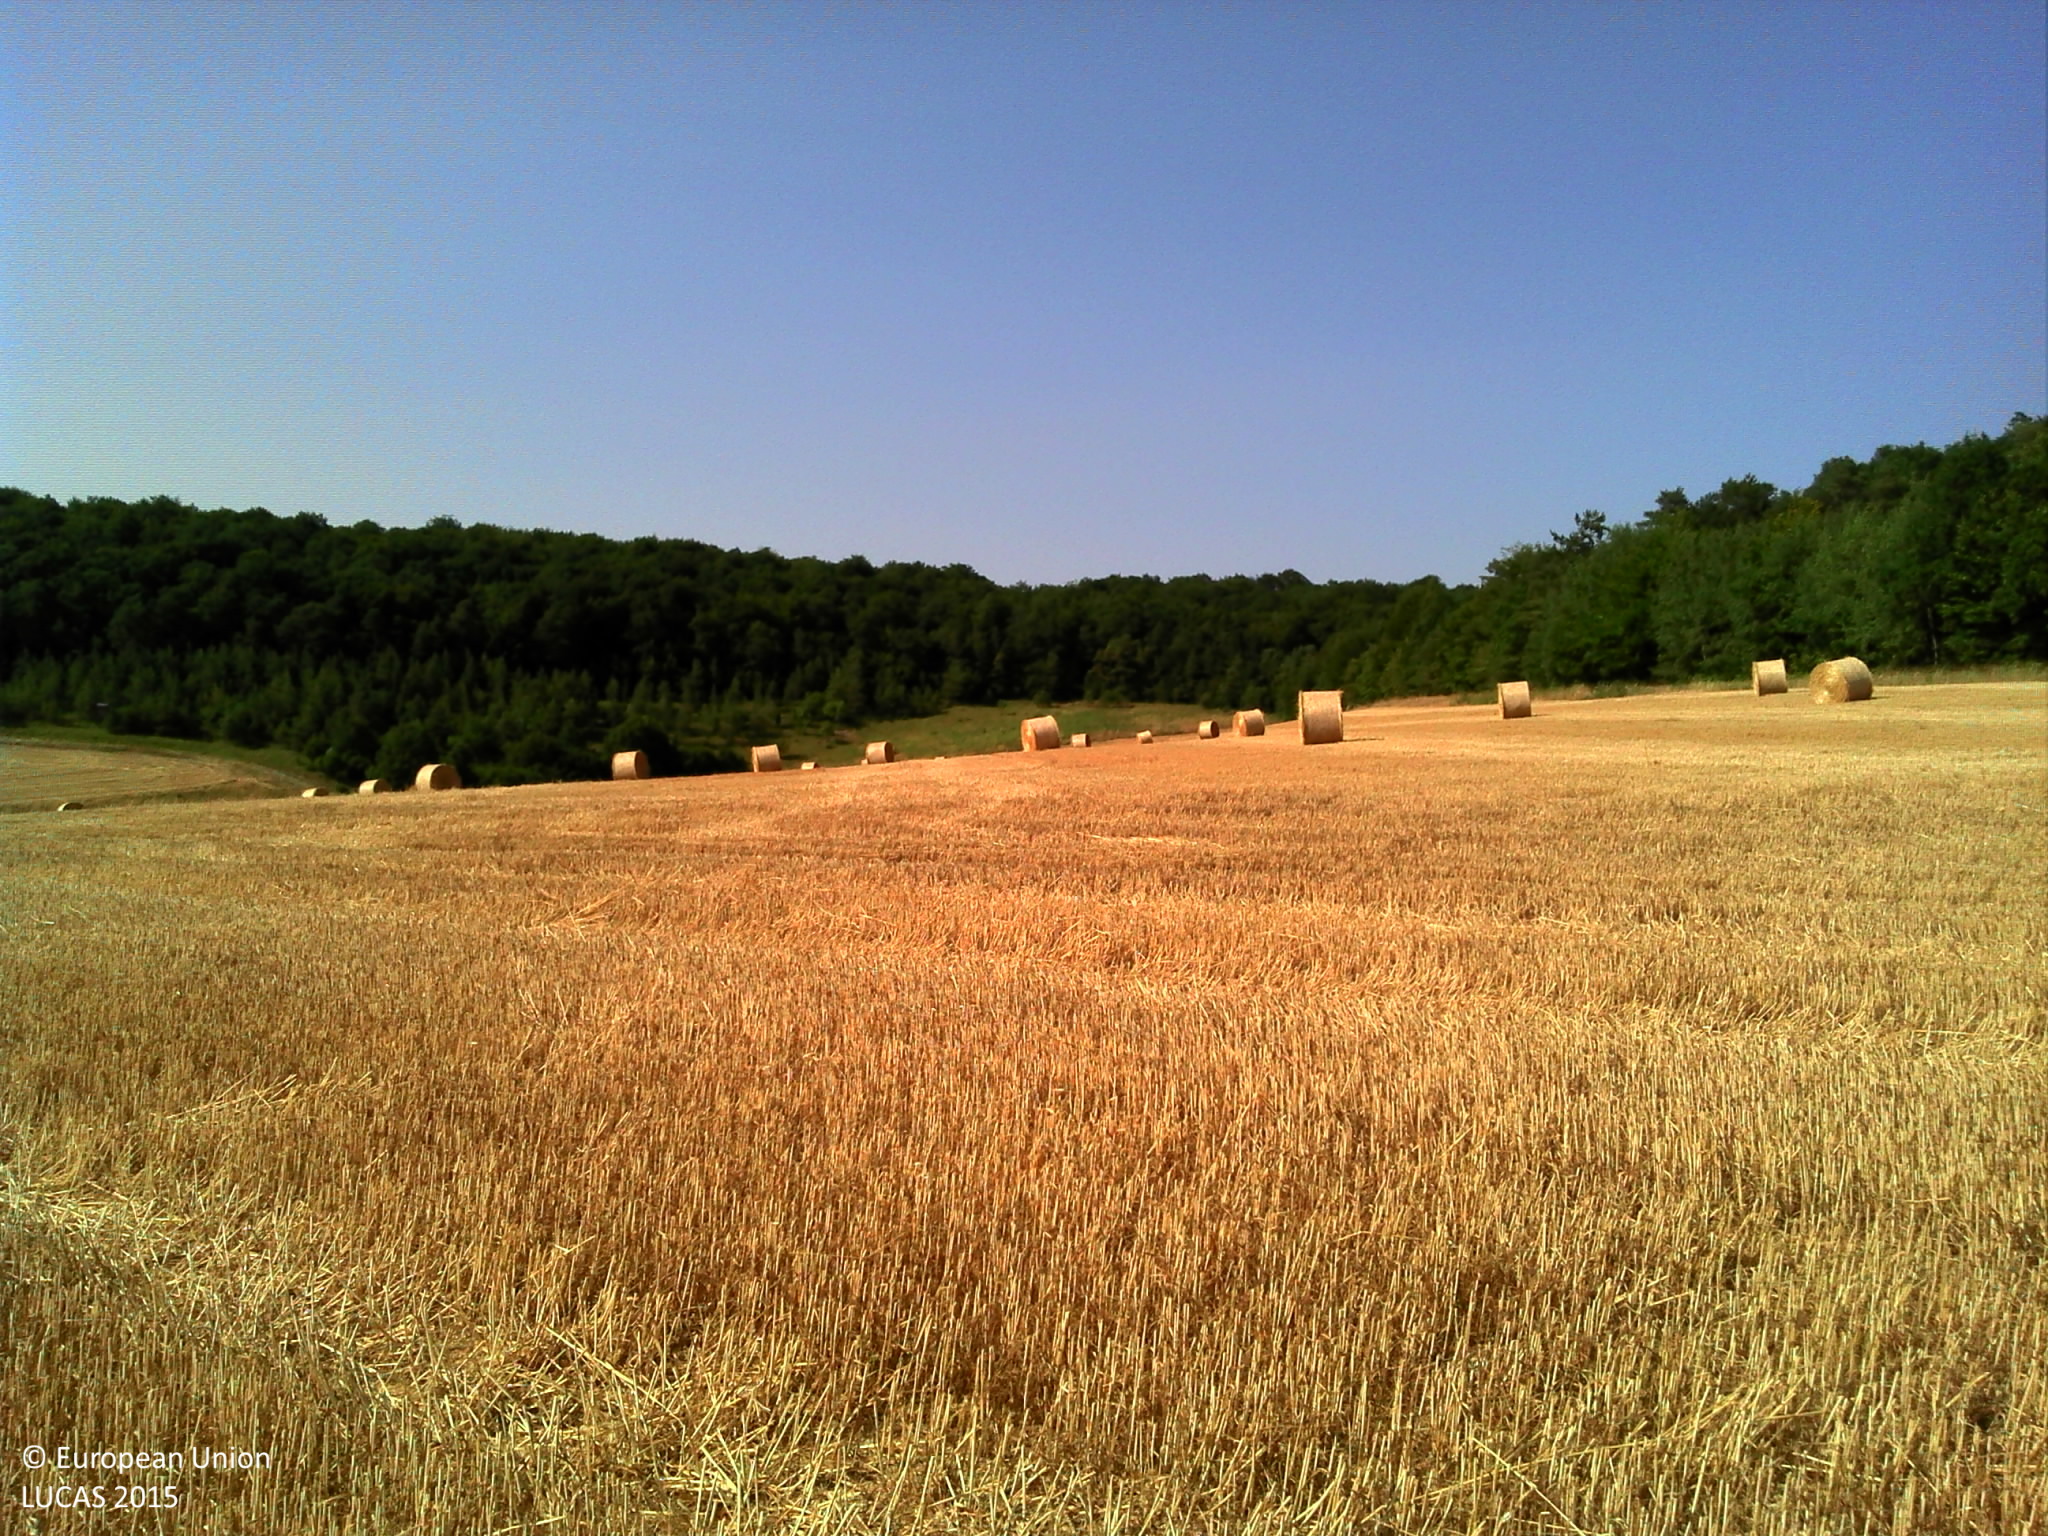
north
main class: Cropland
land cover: Common wheat
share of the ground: 10 - 25 %
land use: Agriculture (excluding fallow land and kitchen gardens)
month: July
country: FR
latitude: 48.1418
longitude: 4.9052
